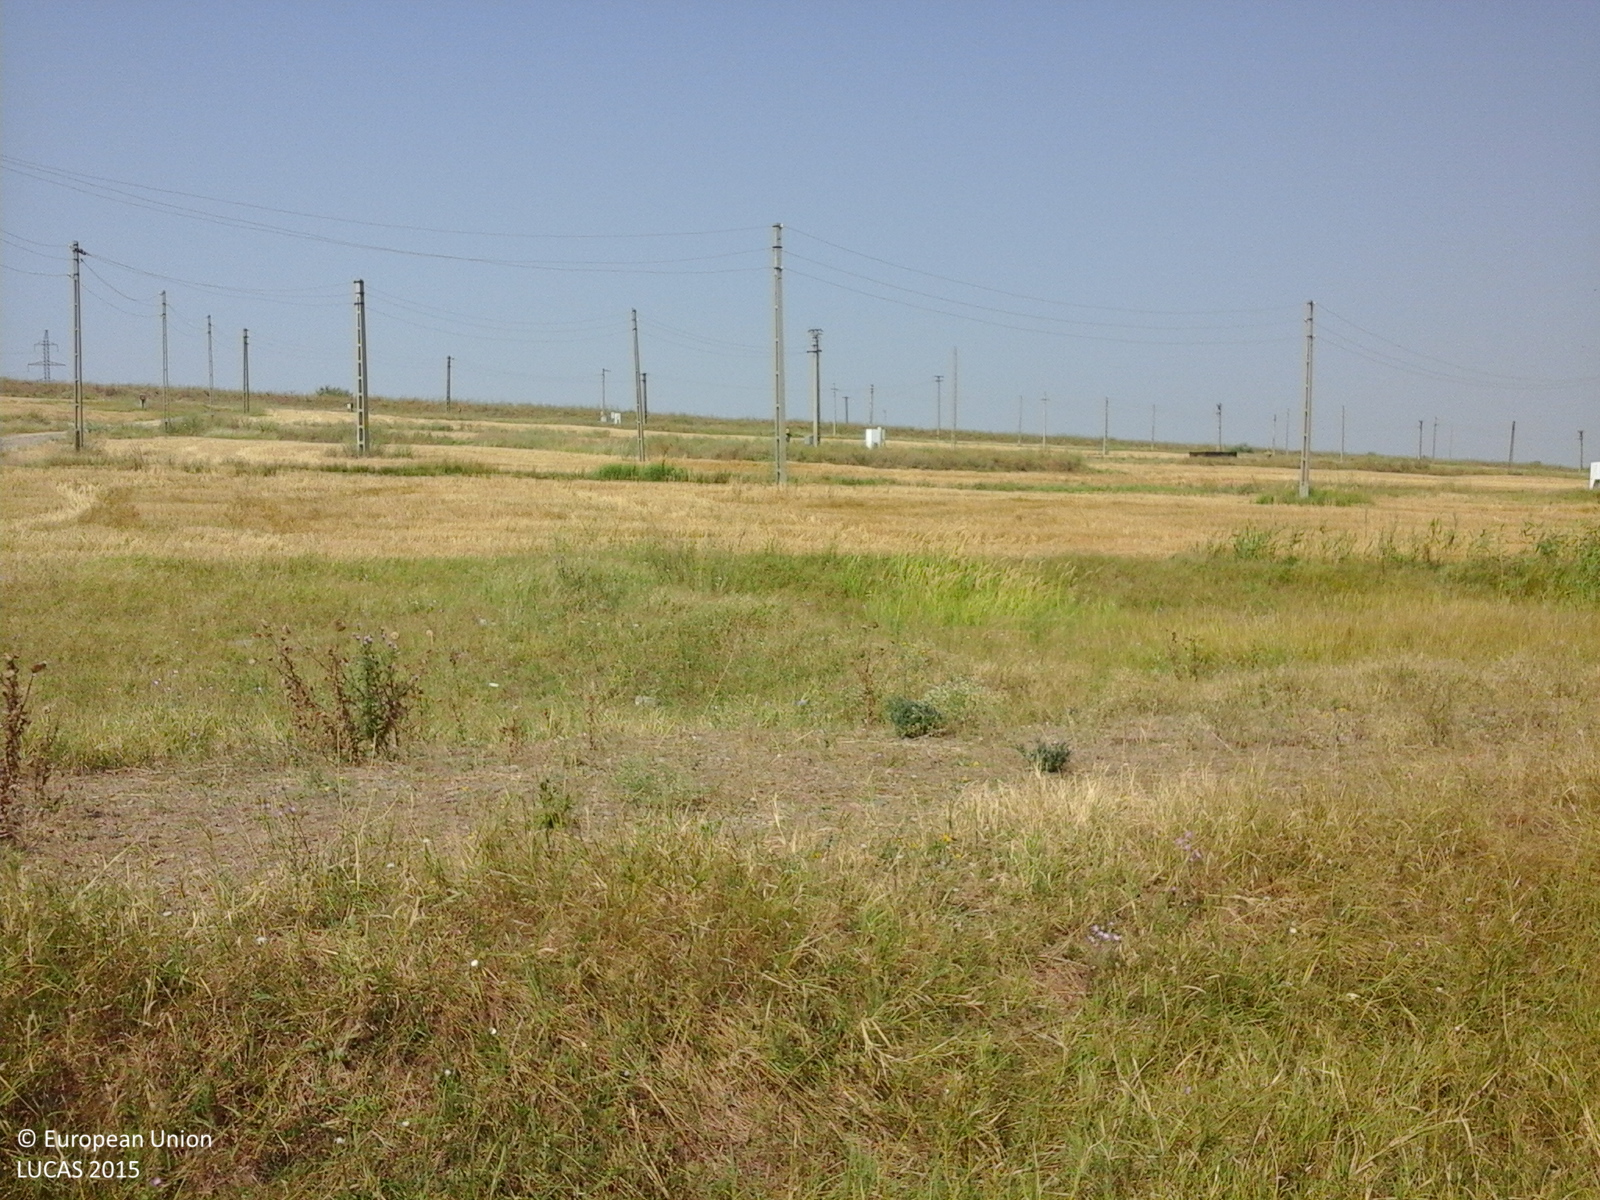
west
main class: Grassland
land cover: Grassland without tree/shrub cover
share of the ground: > 75 %
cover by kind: herbaceous plants 100 %
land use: Agriculture (excluding fallow land and kitchen gardens)
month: July
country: RO
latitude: 45.5213
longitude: 27.8180
